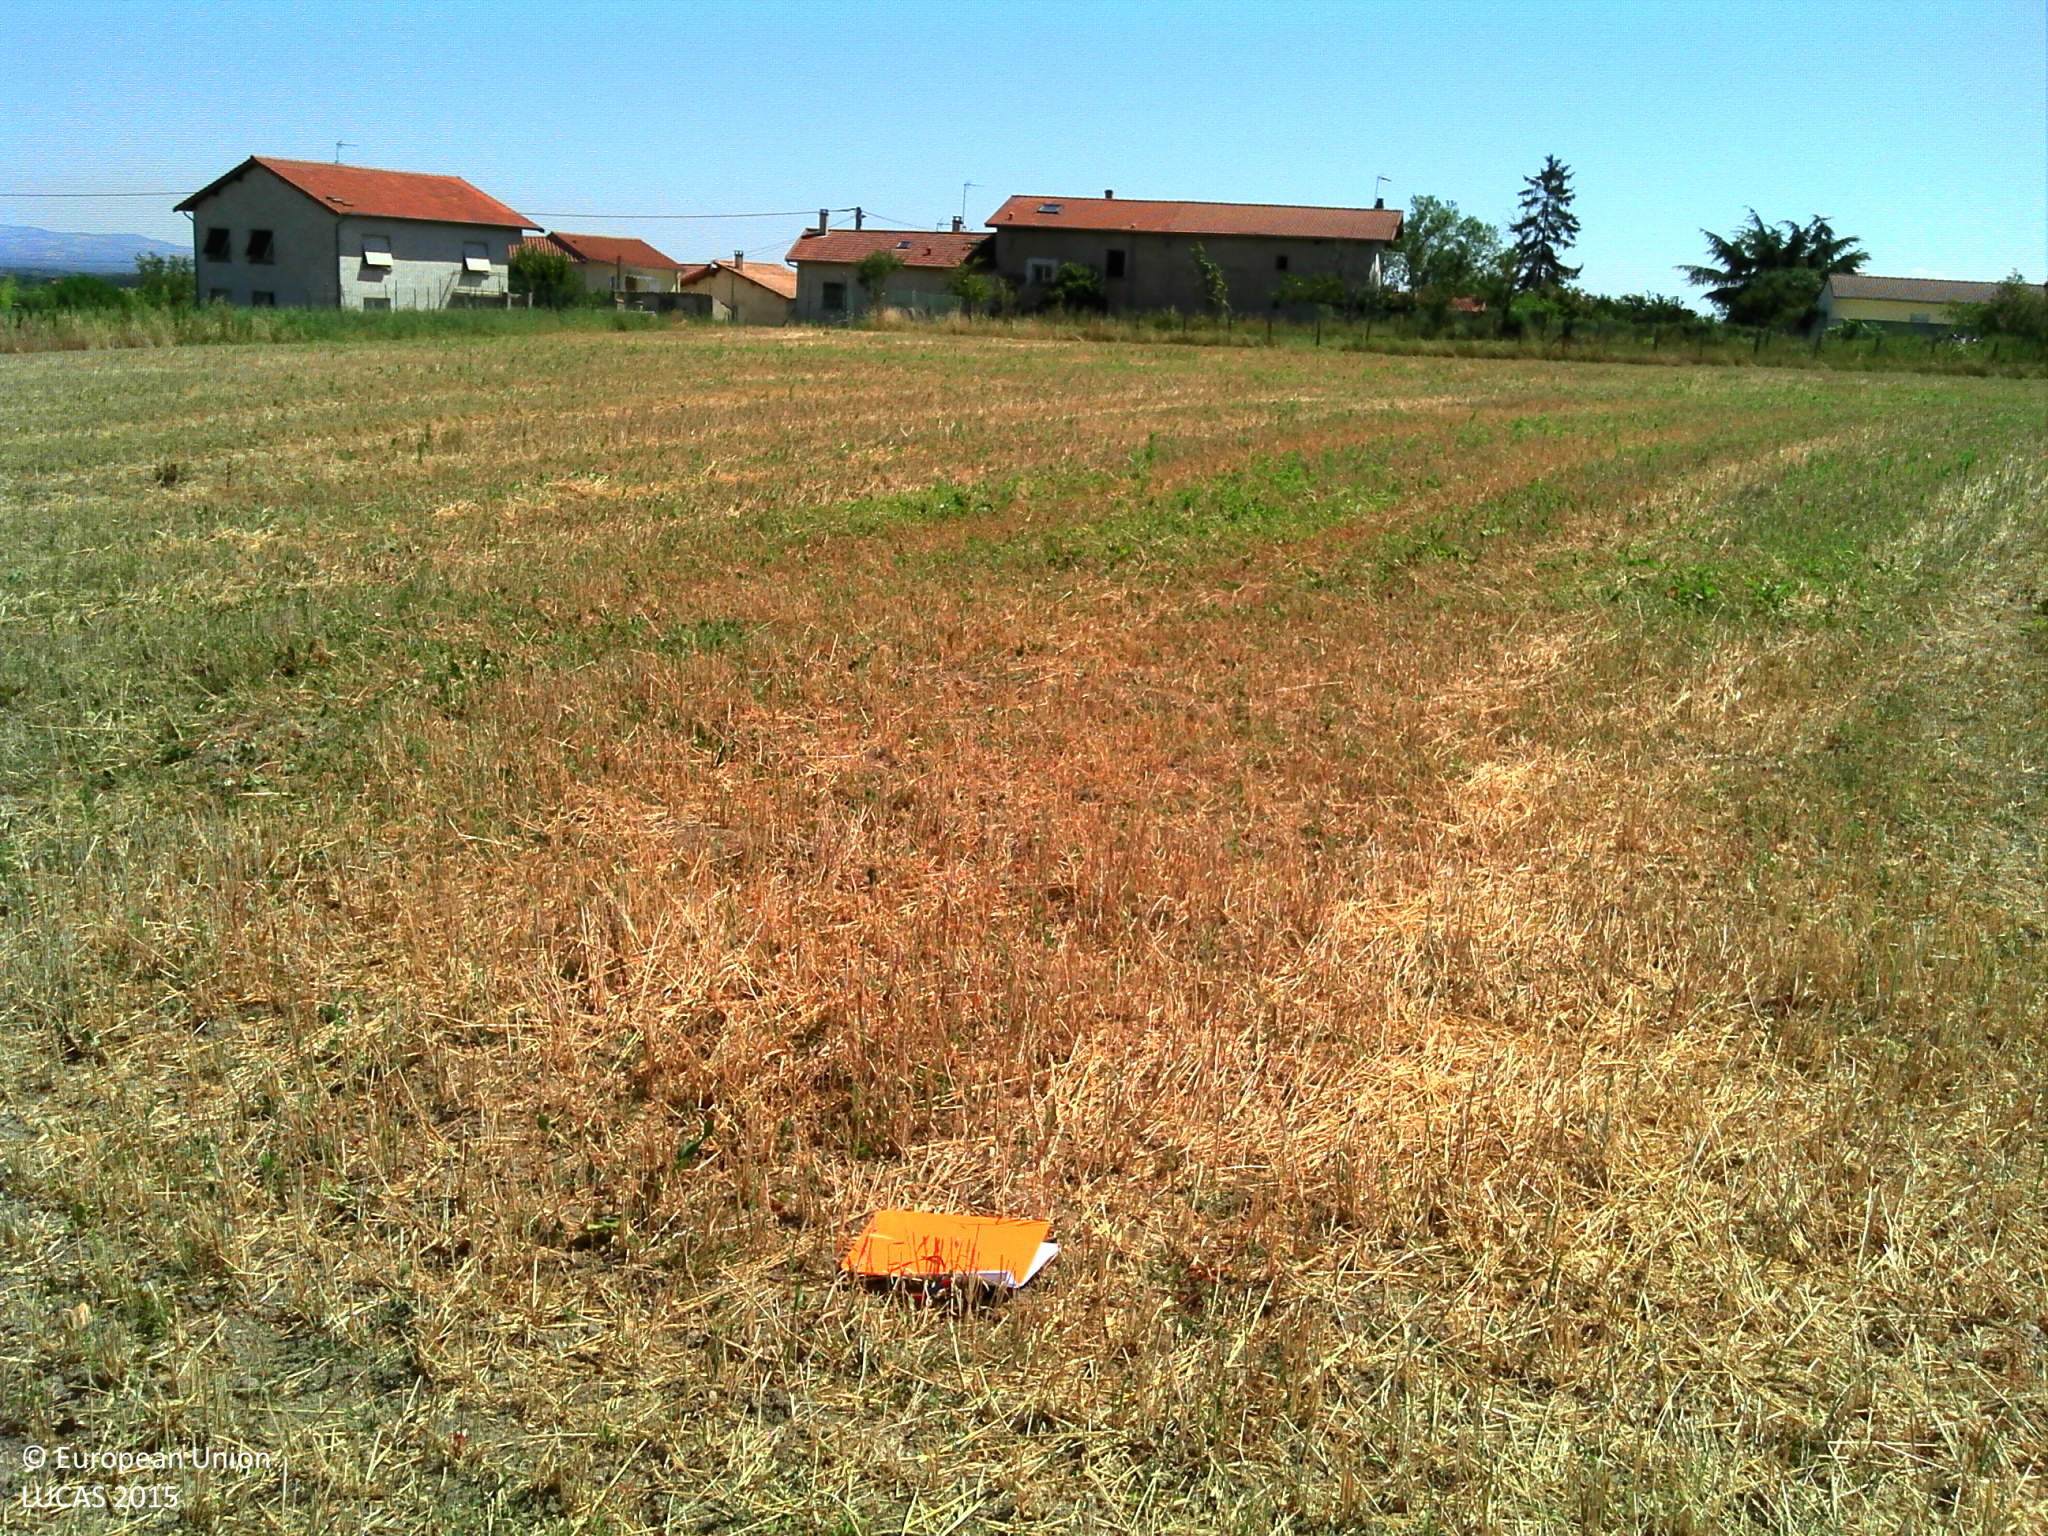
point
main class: Cropland
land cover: Barley
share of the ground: > 75 %
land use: Agriculture (excluding fallow land and kitchen gardens)
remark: Harvested field
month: July
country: FR
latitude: 45.5560
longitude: 4.0974
